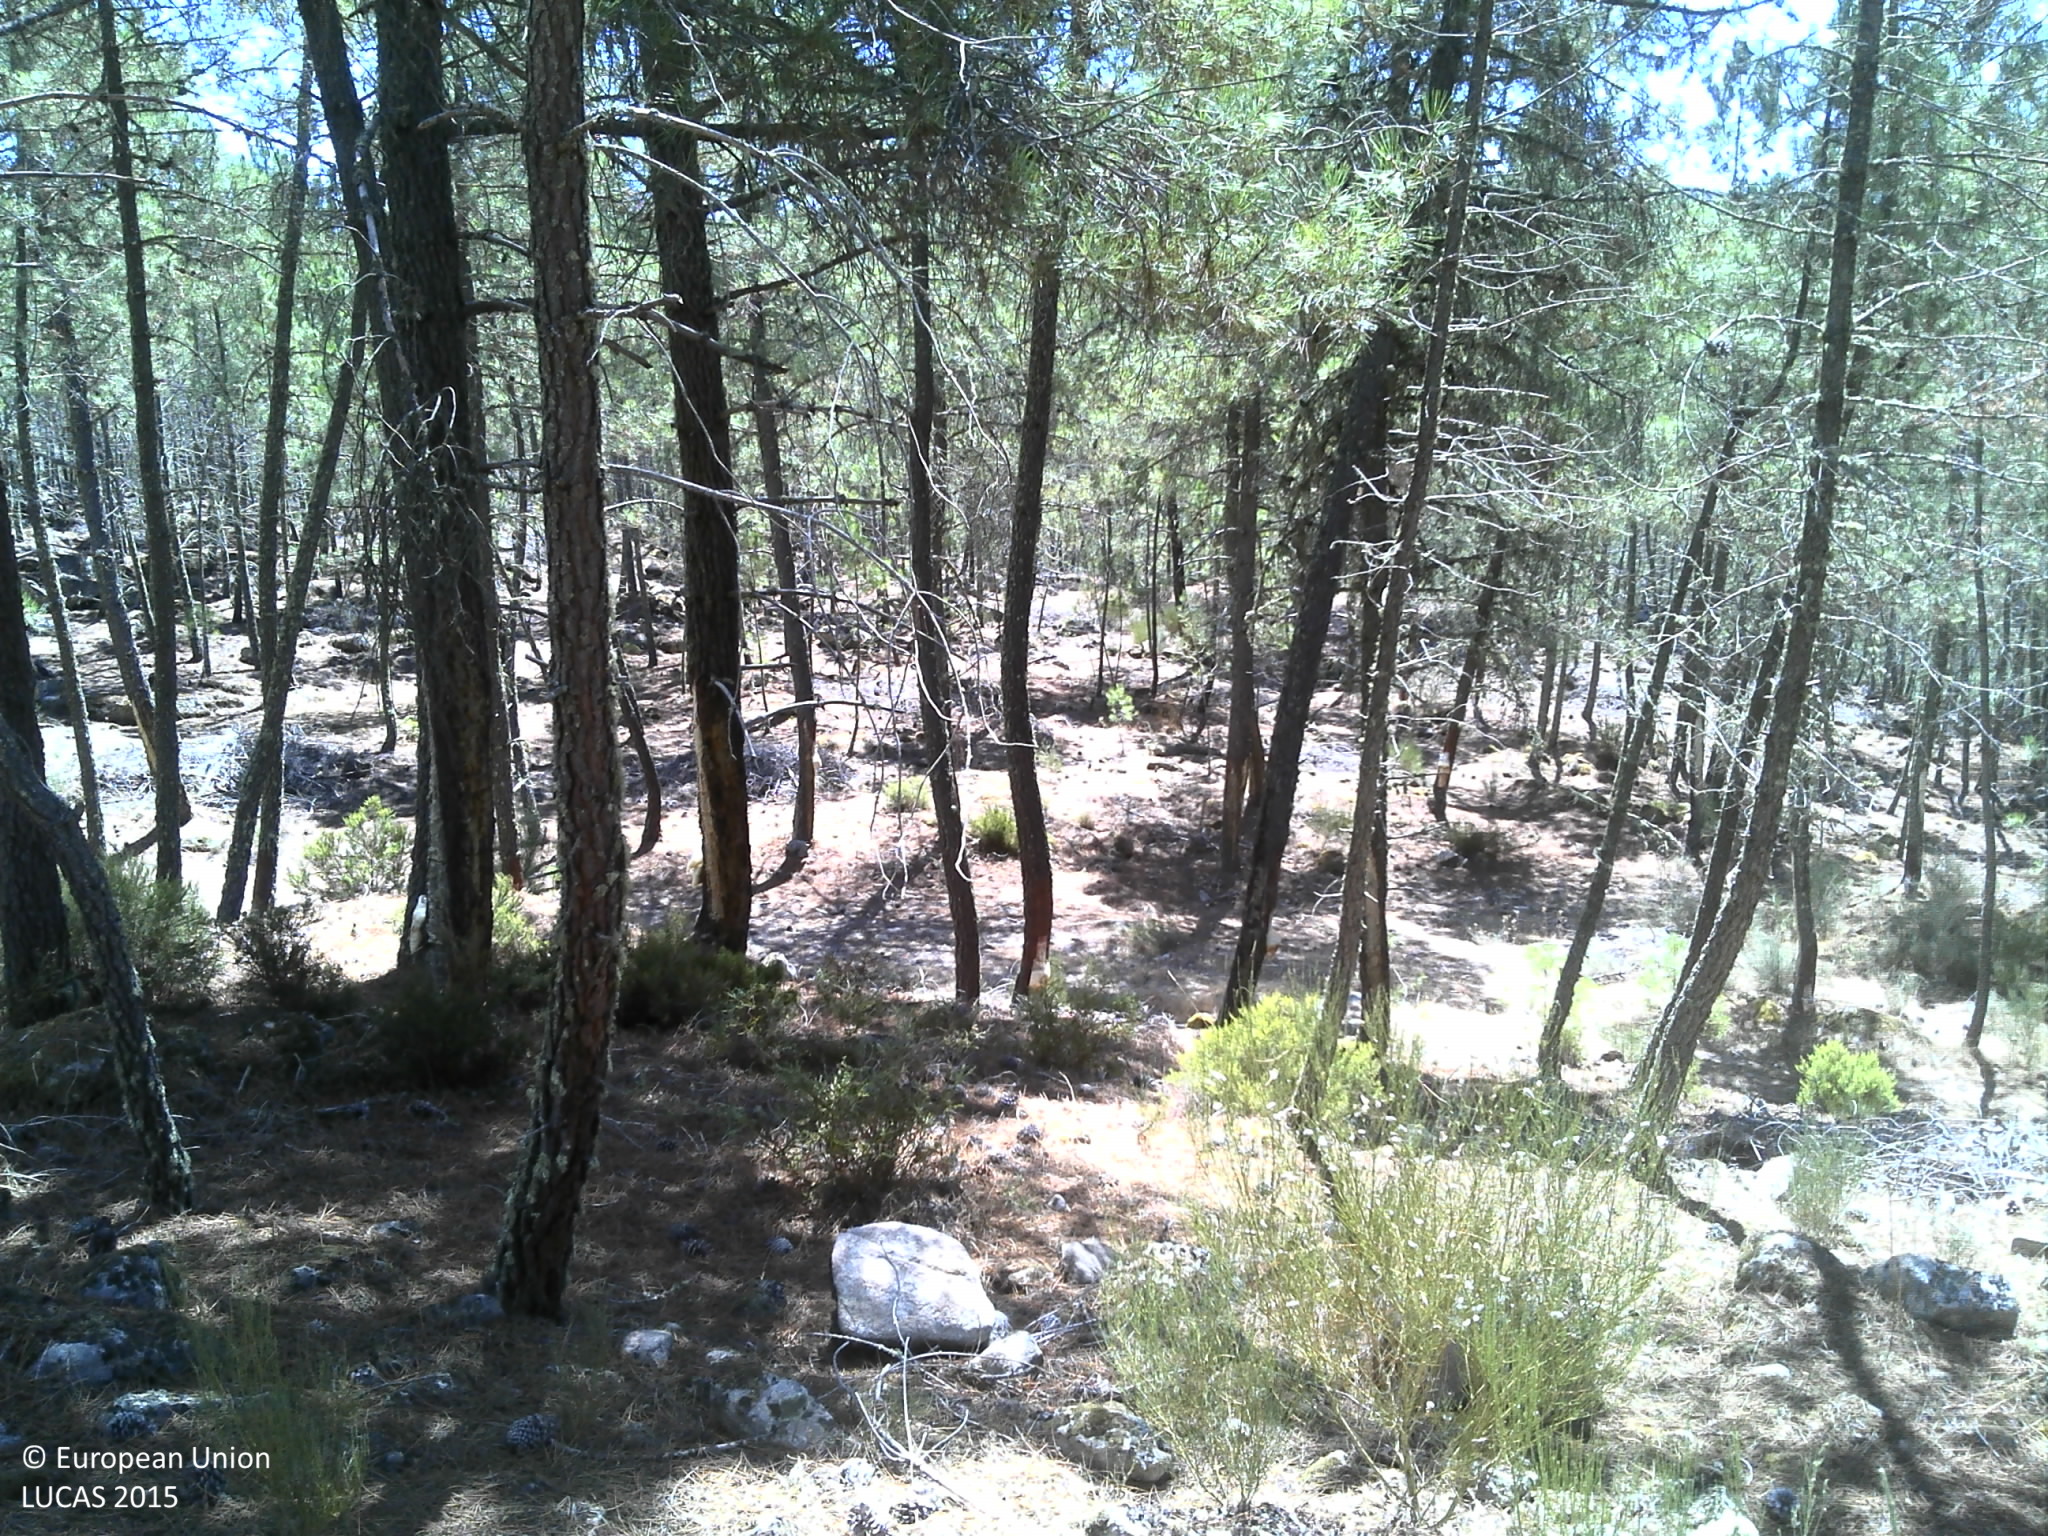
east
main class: Woodland
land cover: Pine dominated coniferous woodland
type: coniferous forest of the mediterranean region
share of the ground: < 10 %
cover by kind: unconsolidated bare surface 80 %, coniferous forest trees 15 %, shrubs 5 %
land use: Forestry
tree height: > 5 m
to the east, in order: Pine dominated coniferous woodland; Tracks; Pine dominated coniferous woodland; Pine dominated mixed woodland; Dry stone walls; Tracks; Dry stone walls; Broadleaved woodland
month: July
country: PT
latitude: 41.3666
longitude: -7.5447
